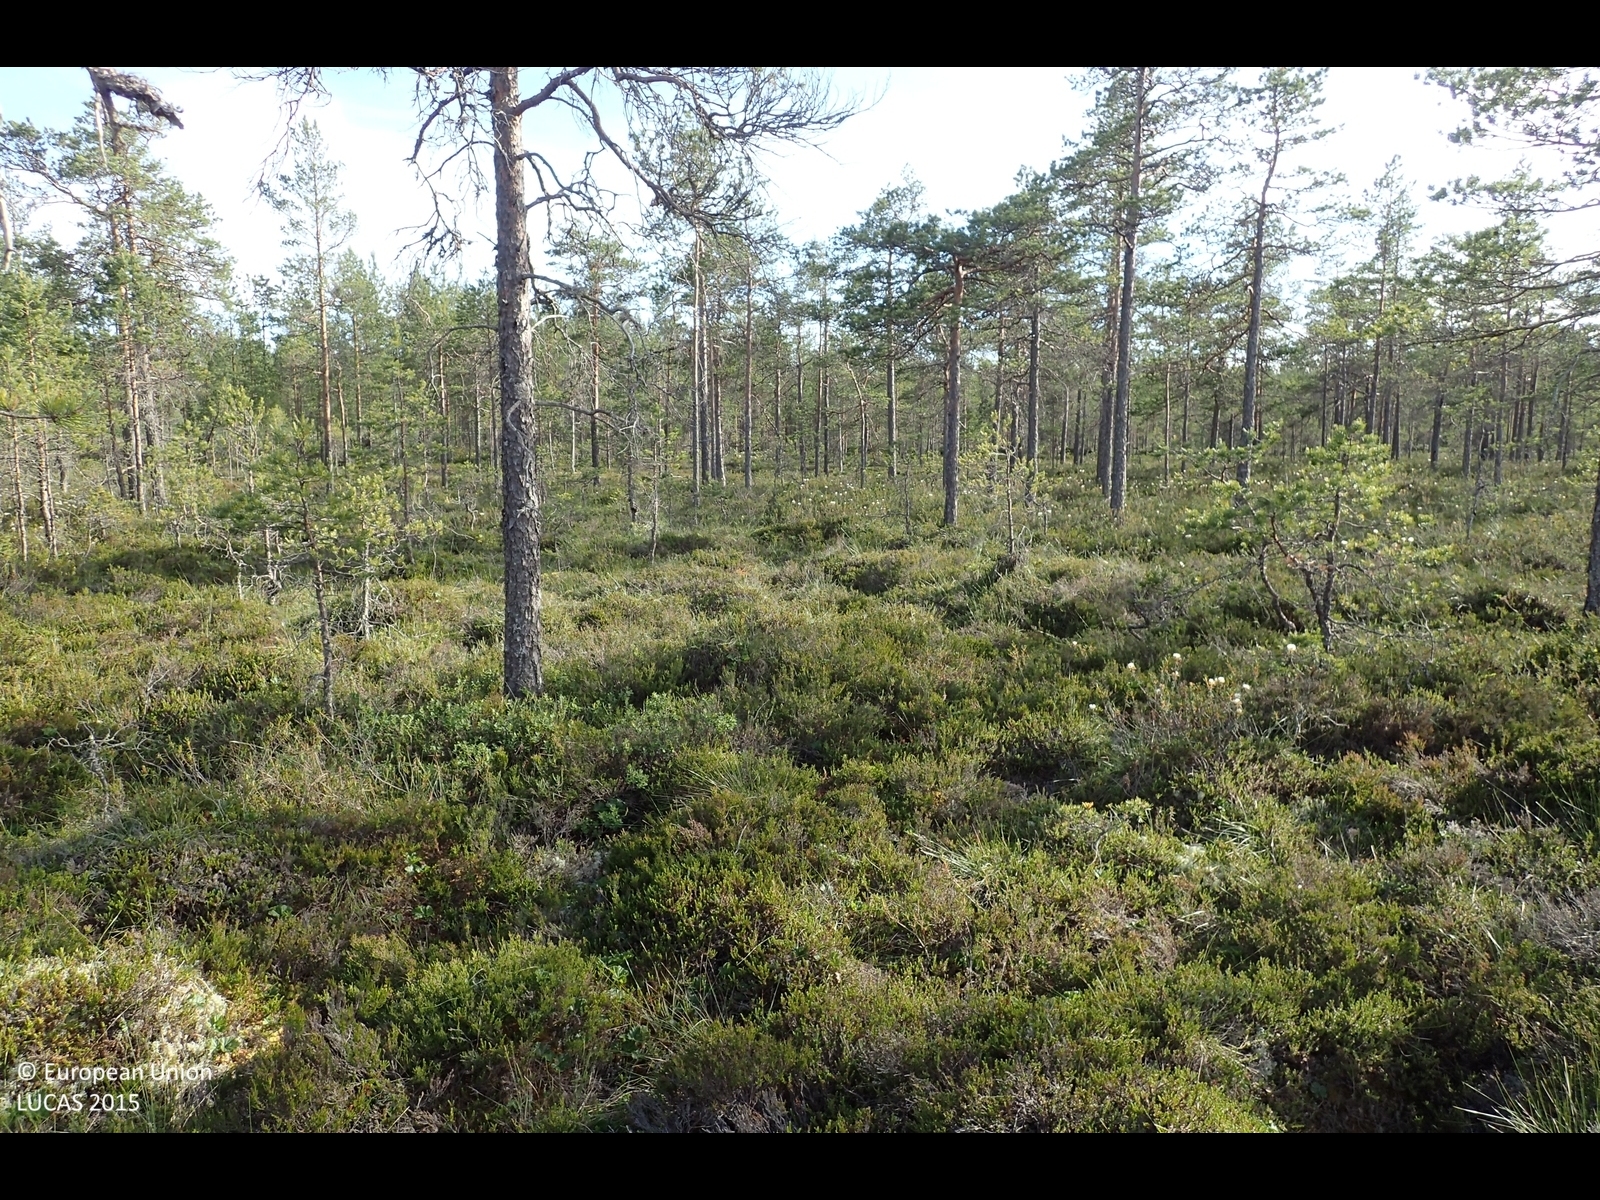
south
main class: Woodland
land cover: Pine dominated coniferous woodland
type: mire and swamp forests
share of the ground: 25 - 50 %
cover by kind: shrubs 65 %, coniferous forest trees 30 %, lichens and mosses 5 %
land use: Forestry
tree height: < 5 m
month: July
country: FI
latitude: 62.5450
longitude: 21.6121
